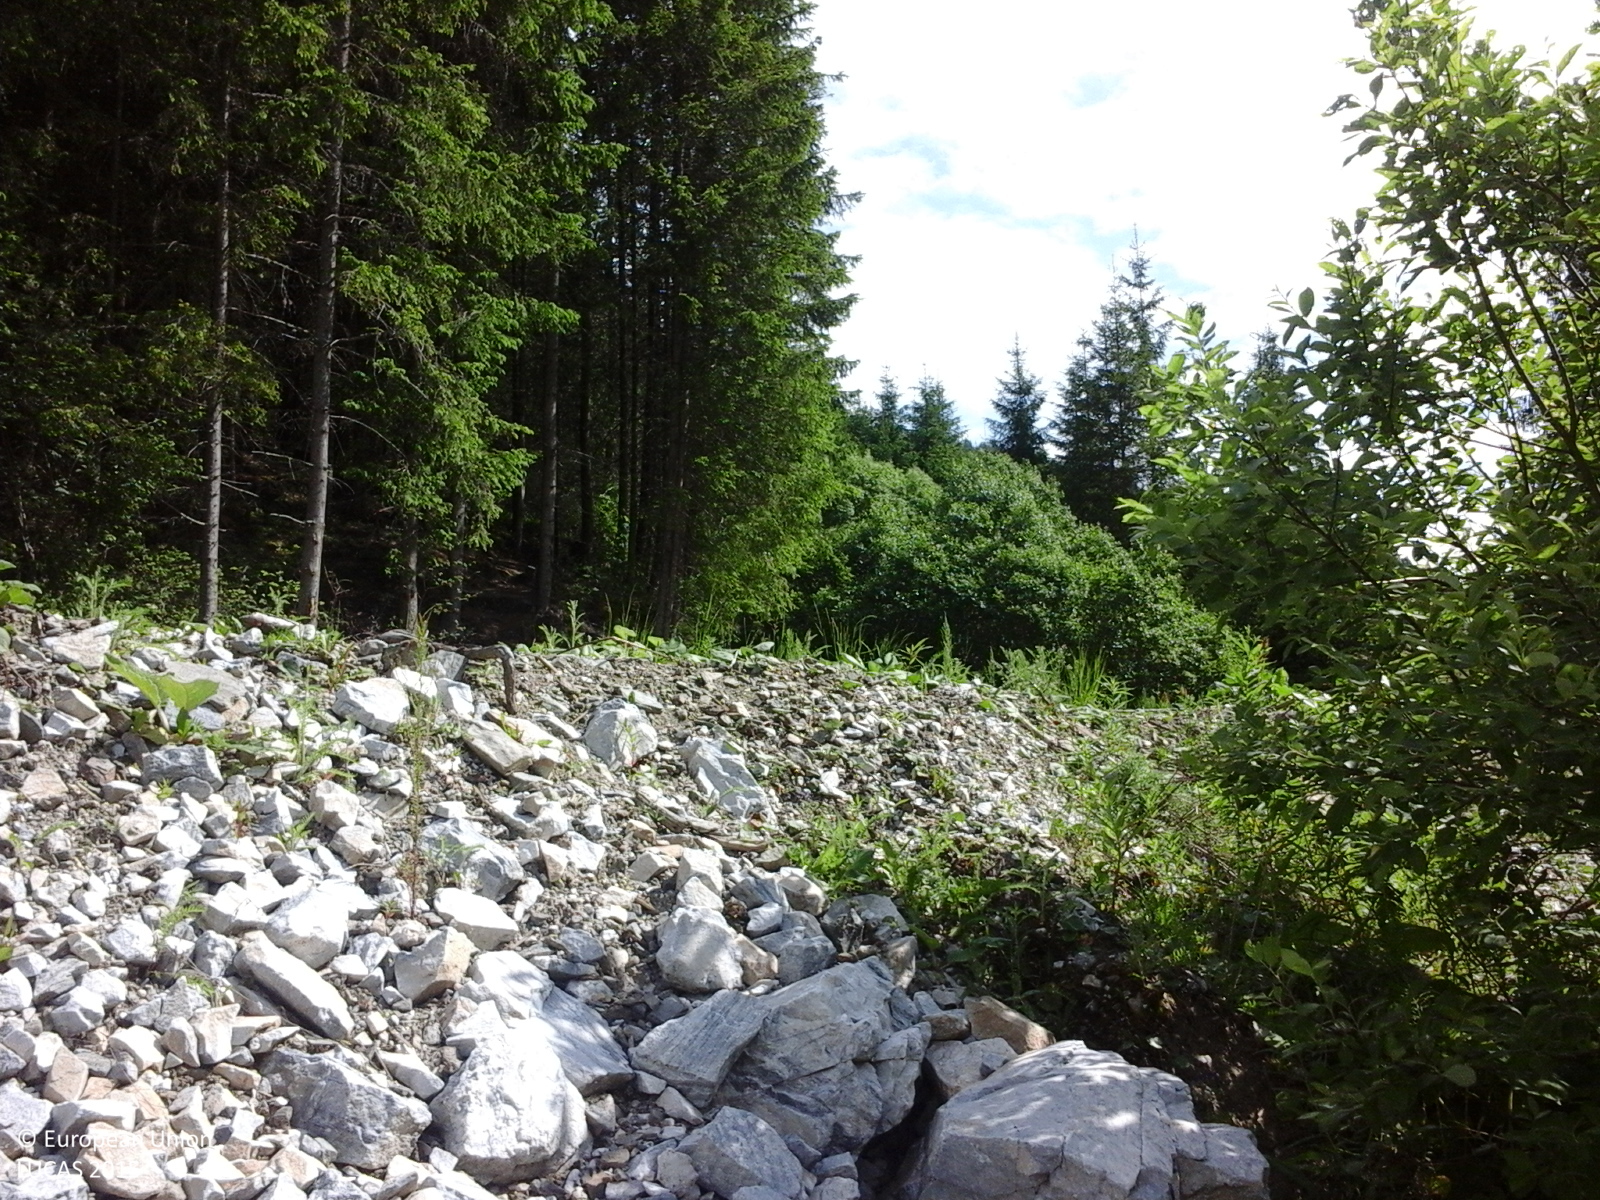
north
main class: Woodland
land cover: Spruce dominated mixed woodland
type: alpine coniferous forest
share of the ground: > 75 %
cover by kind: coniferous forest trees 75 %, broadleaved forest trees 25 %
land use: Forestry
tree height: > 5 m
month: June
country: RO
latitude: 47.2985
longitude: 25.5221
